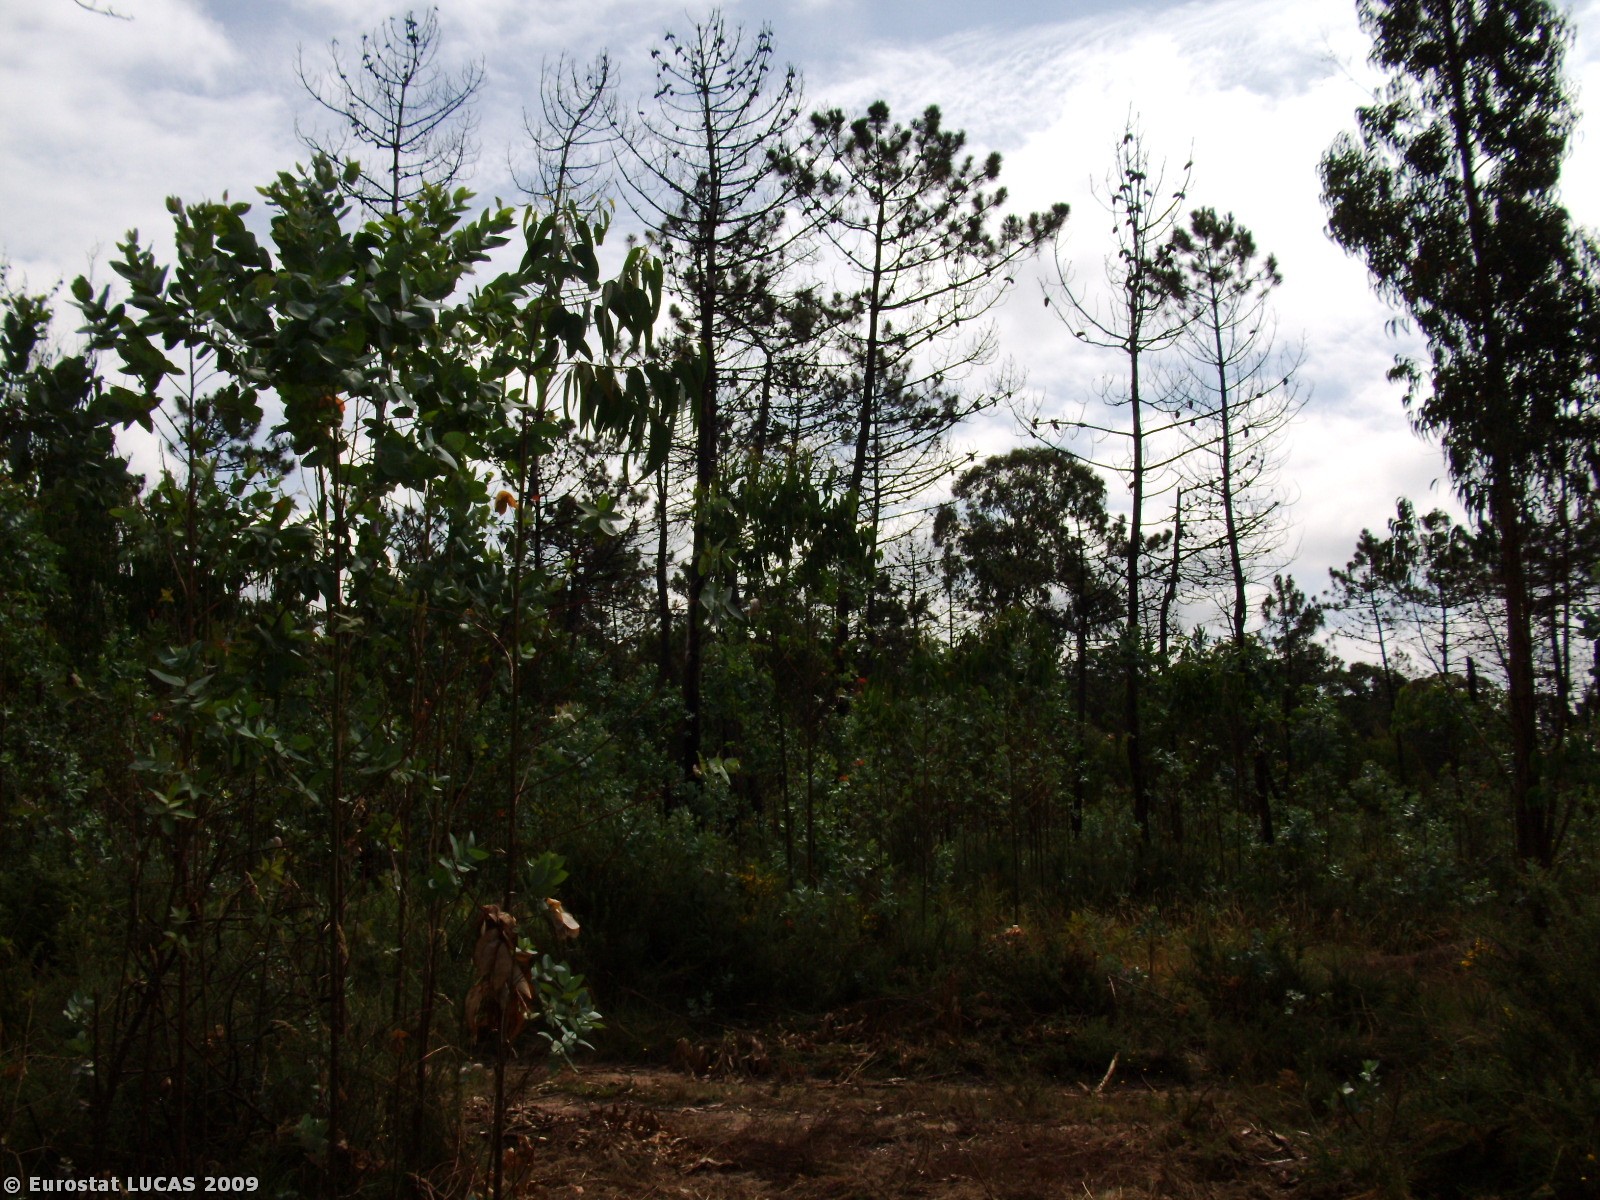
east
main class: Woodland
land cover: Broadleaved woodland
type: plantations and self-sown exotic forest
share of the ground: 50 - 75 %
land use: Forestry
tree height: > 5 m
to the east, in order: Broadleaved woodland; Tracks; Broadleaved woodland; Coniferous woodland; Tracks; Mixed woodland; Tracks; Mixed woodland
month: June
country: PT
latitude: 41.4613
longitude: -8.7307
